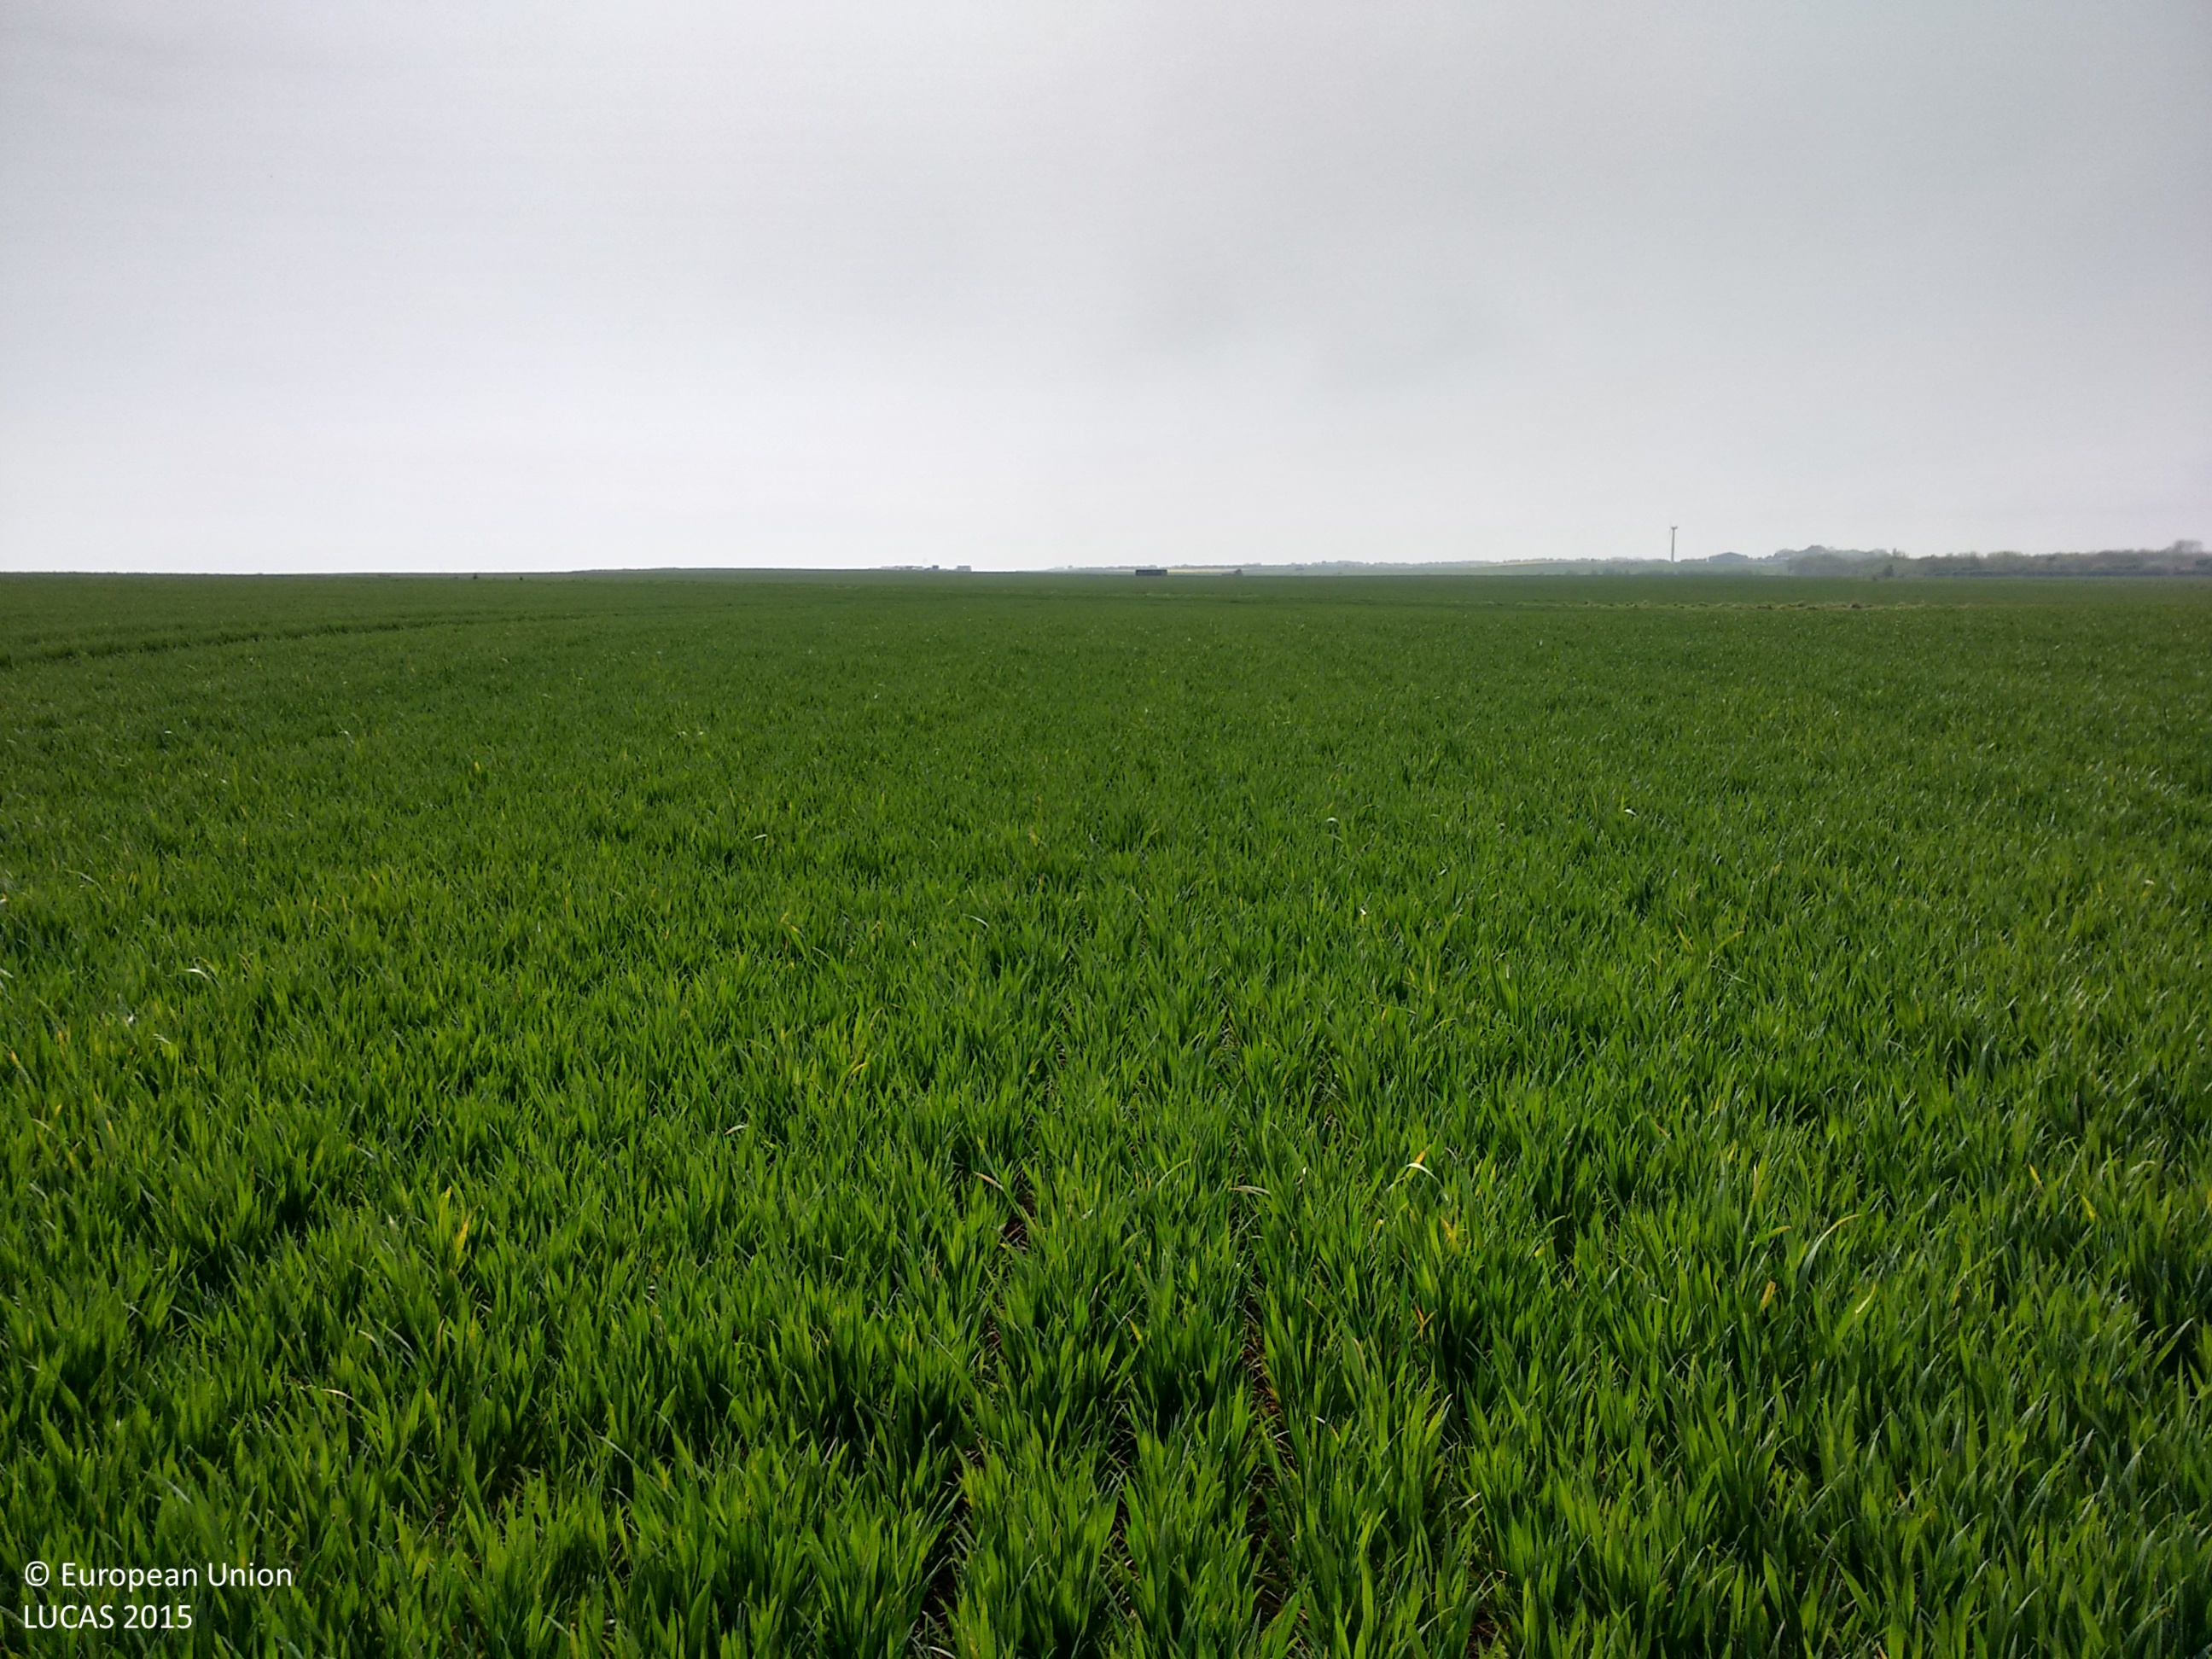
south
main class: Cropland
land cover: Common wheat
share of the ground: > 75 %
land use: Agriculture (excluding fallow land and kitchen gardens)
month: May
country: GB
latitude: 53.9848
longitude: -0.2051
